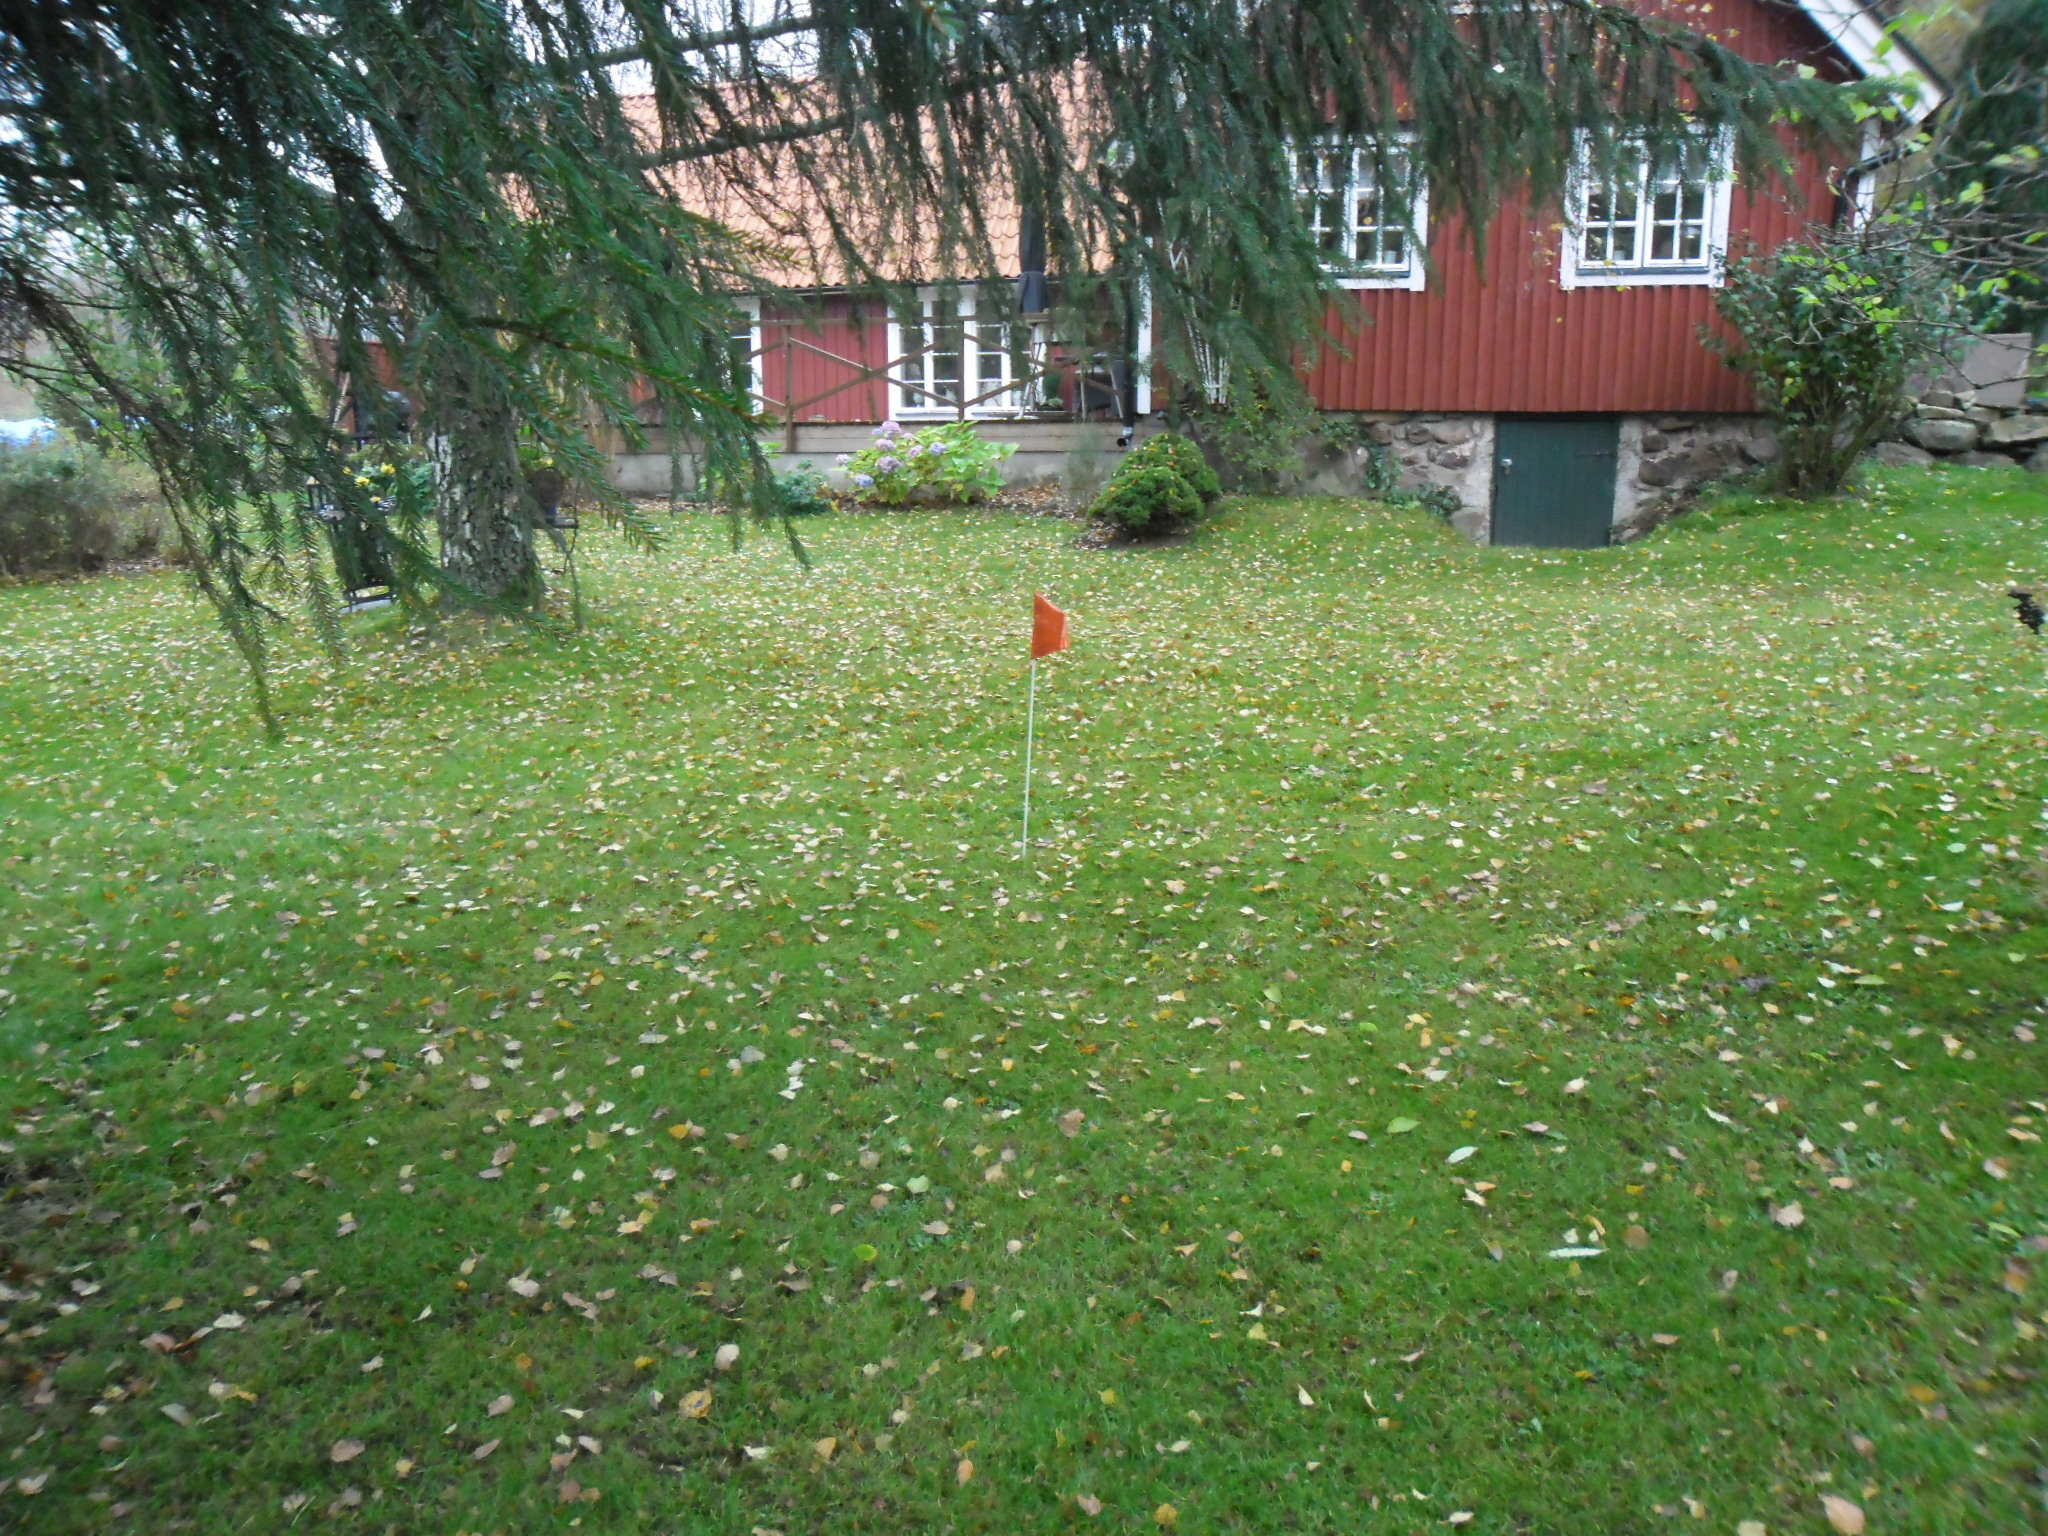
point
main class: Woodland
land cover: Spruce dominated mixed woodland
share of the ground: 50 - 75 %
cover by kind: coniferous forest trees 40 %, herbaceous plants 40 %, broadleaved forest trees 20 %
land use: Residential
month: November
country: SE
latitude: 56.3538
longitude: 12.8617
